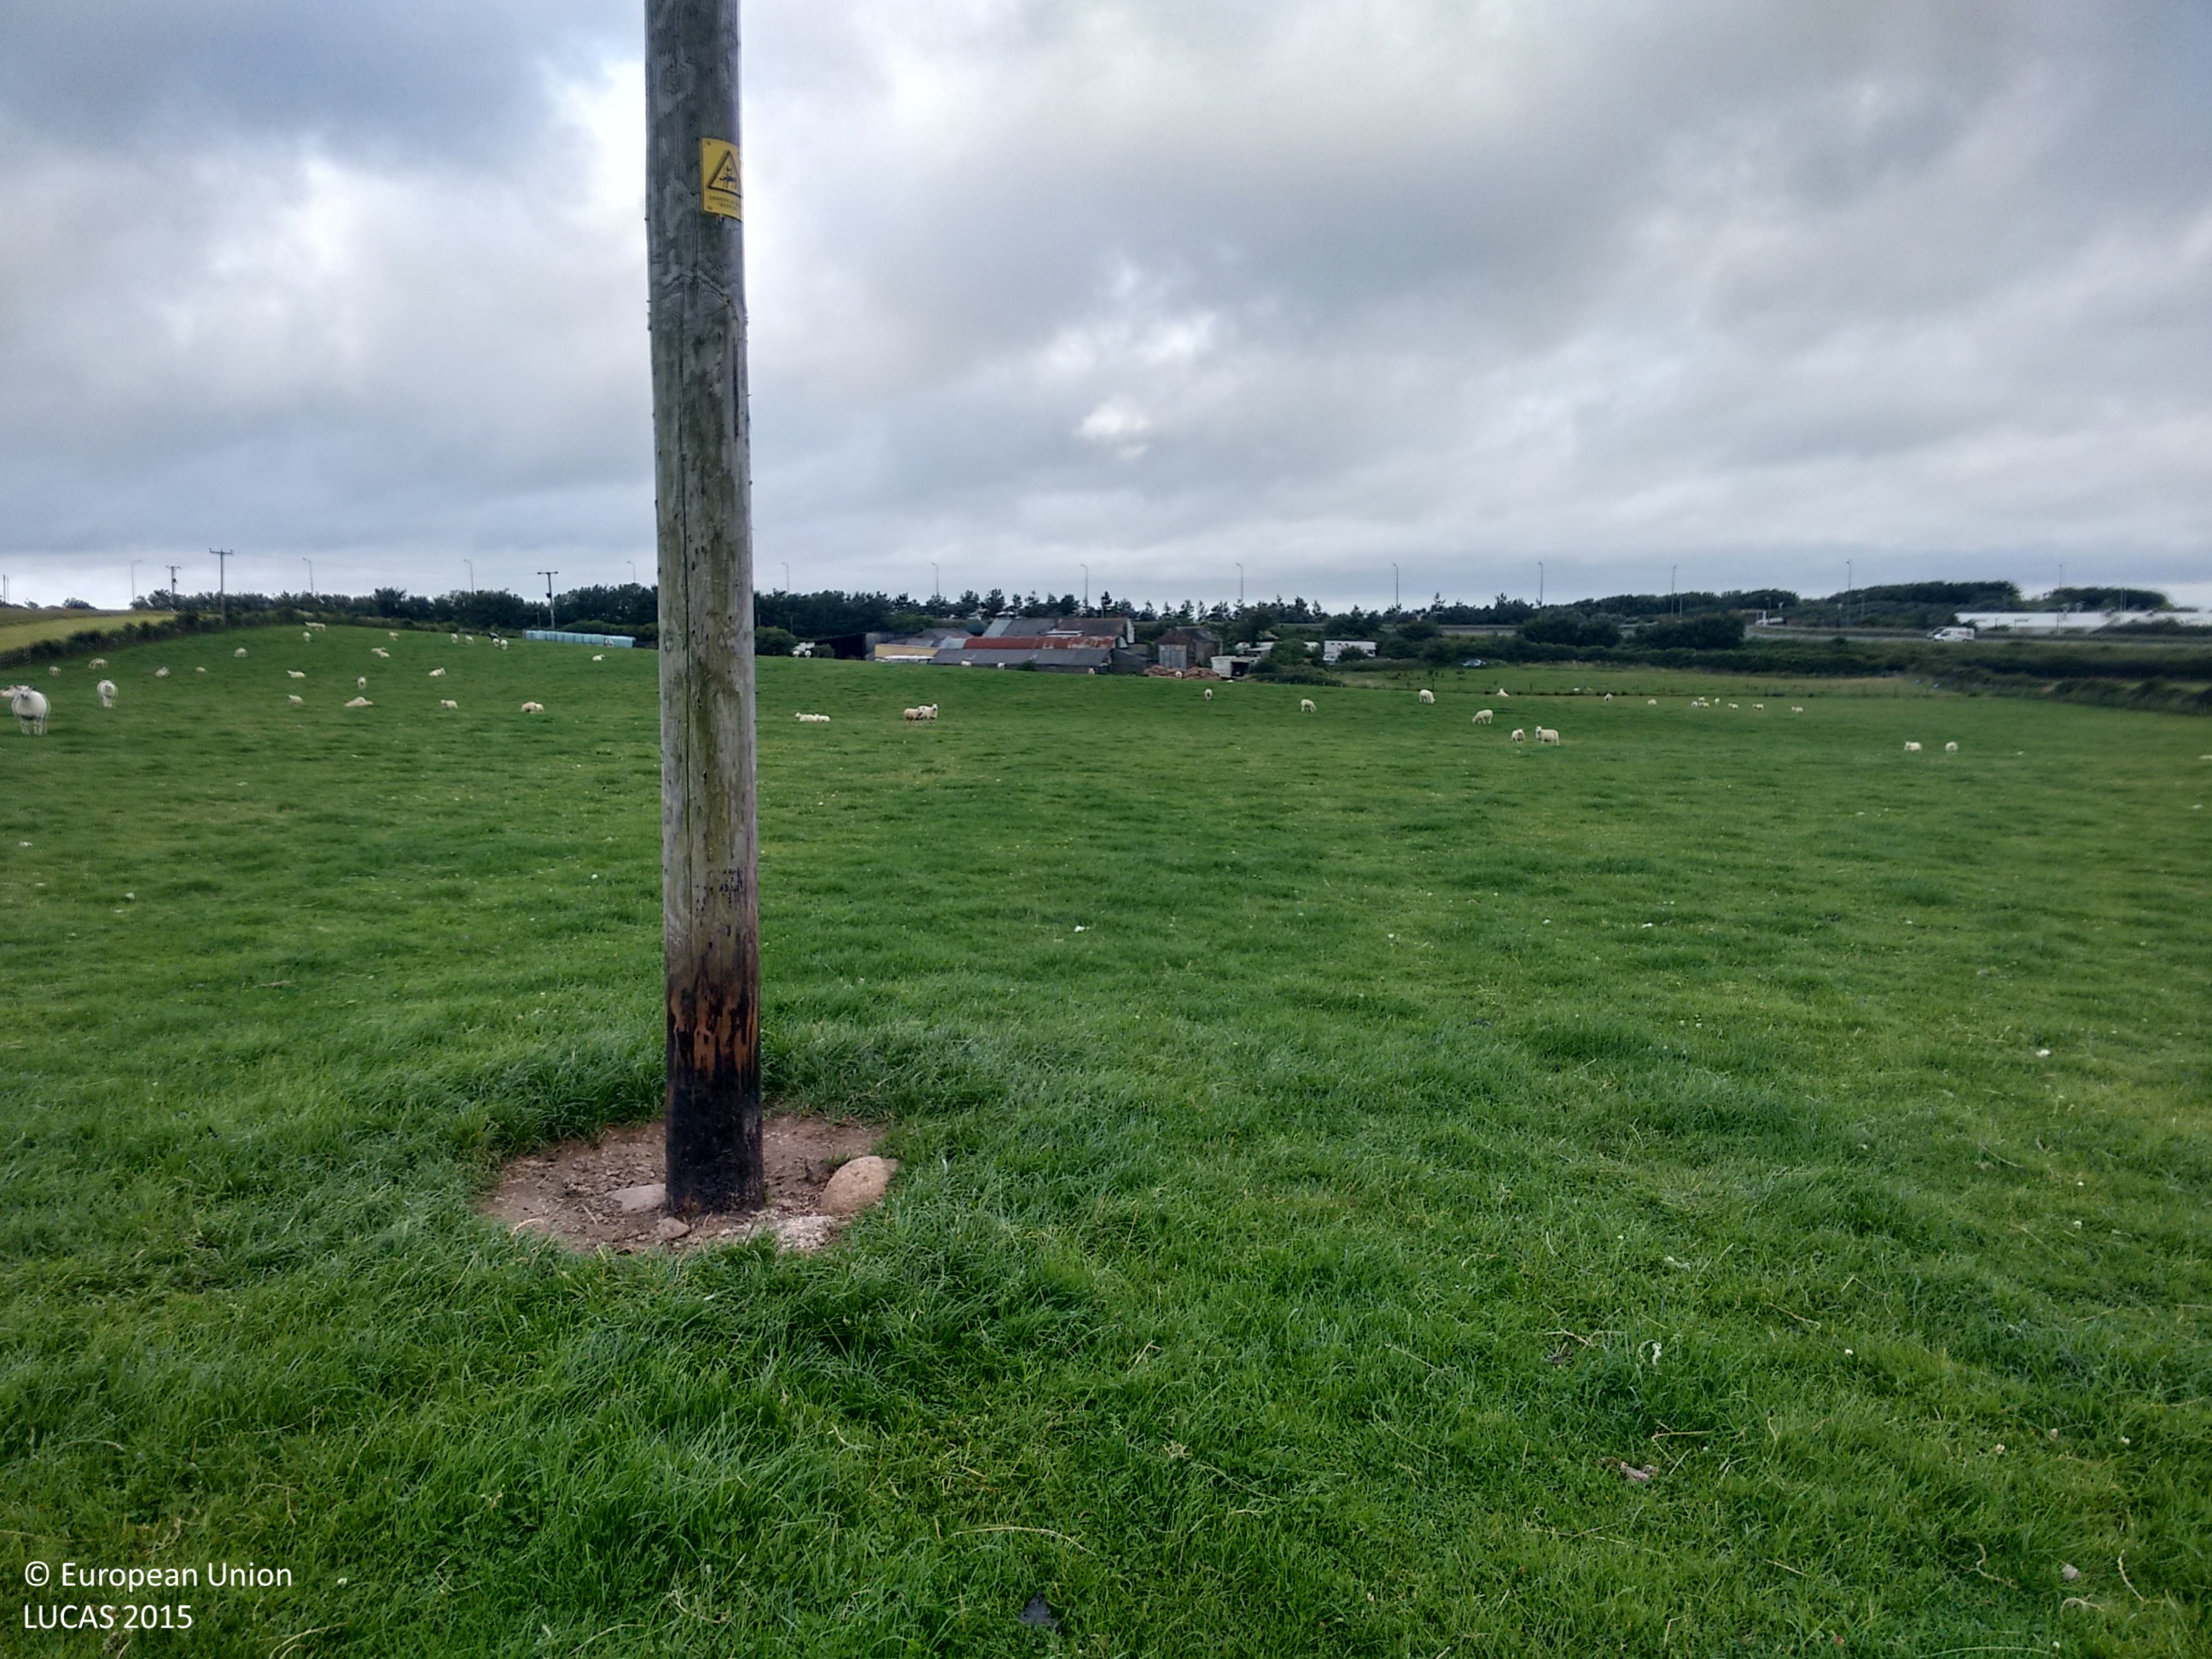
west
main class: Grassland
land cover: Grassland without tree/shrub cover
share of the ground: > 75 %
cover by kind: herbaceous plants 100 %
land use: Agriculture (excluding fallow land and kitchen gardens)
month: August
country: GB
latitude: 54.7027
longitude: -3.5049
